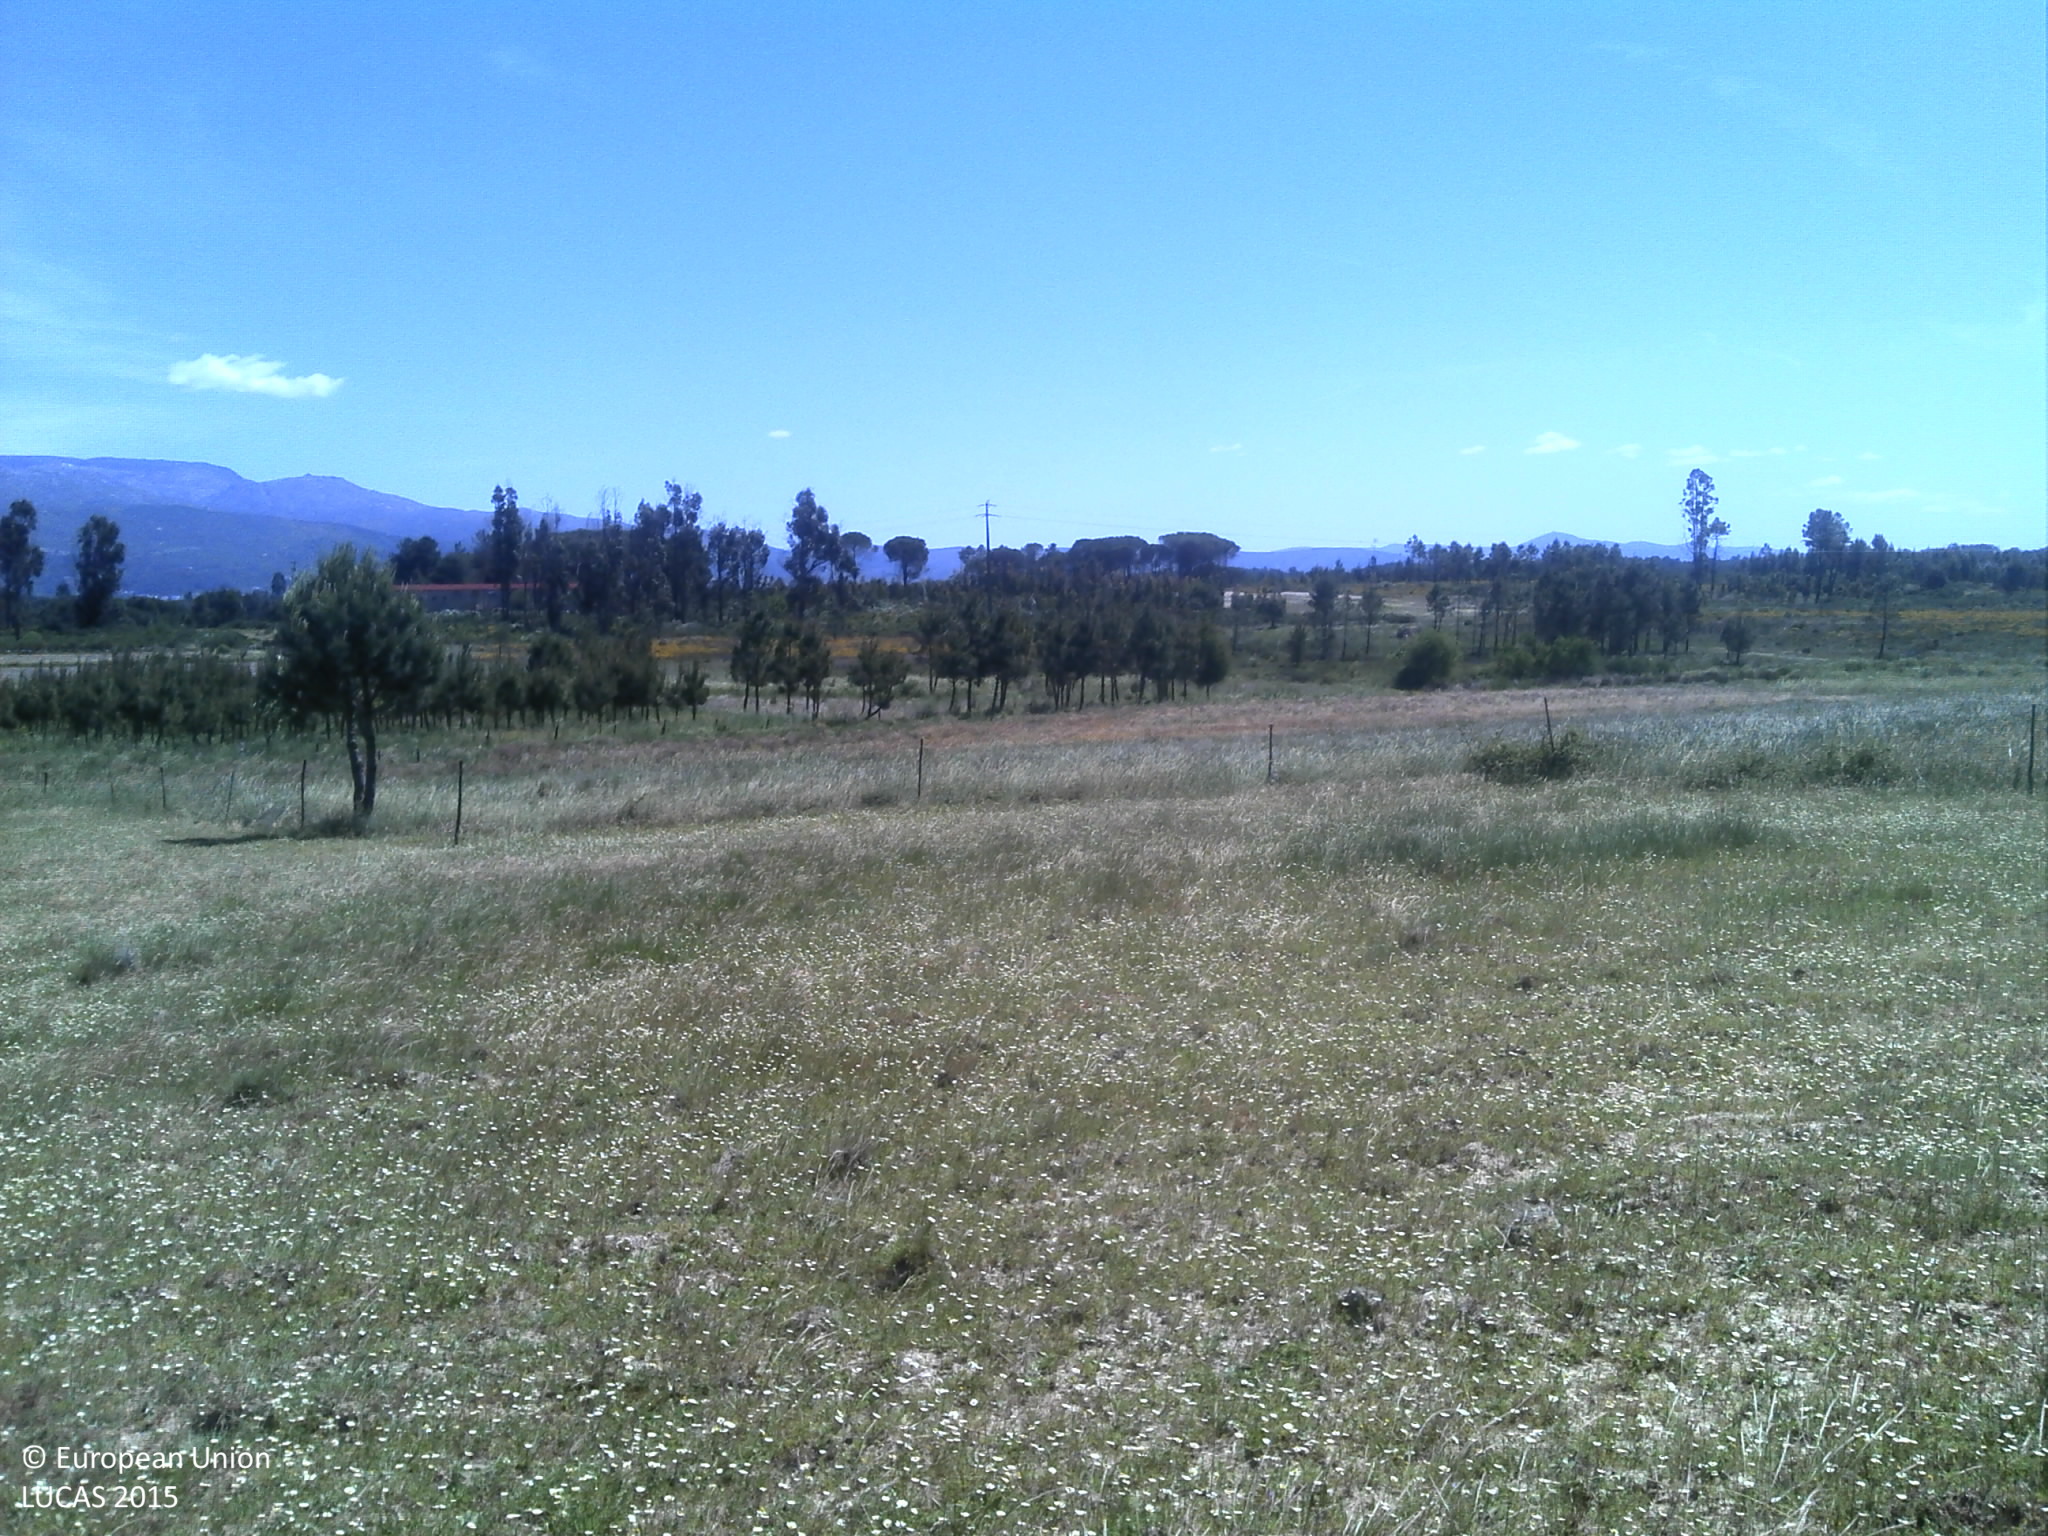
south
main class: Grassland
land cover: Grassland without tree/shrub cover
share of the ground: 25 - 50 %
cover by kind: herbaceous plants 50 %, unconsolidated bare surface 50 %
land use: Agriculture (excluding fallow land and kitchen gardens)
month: May
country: PT
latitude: 40.4845
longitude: -7.7296
